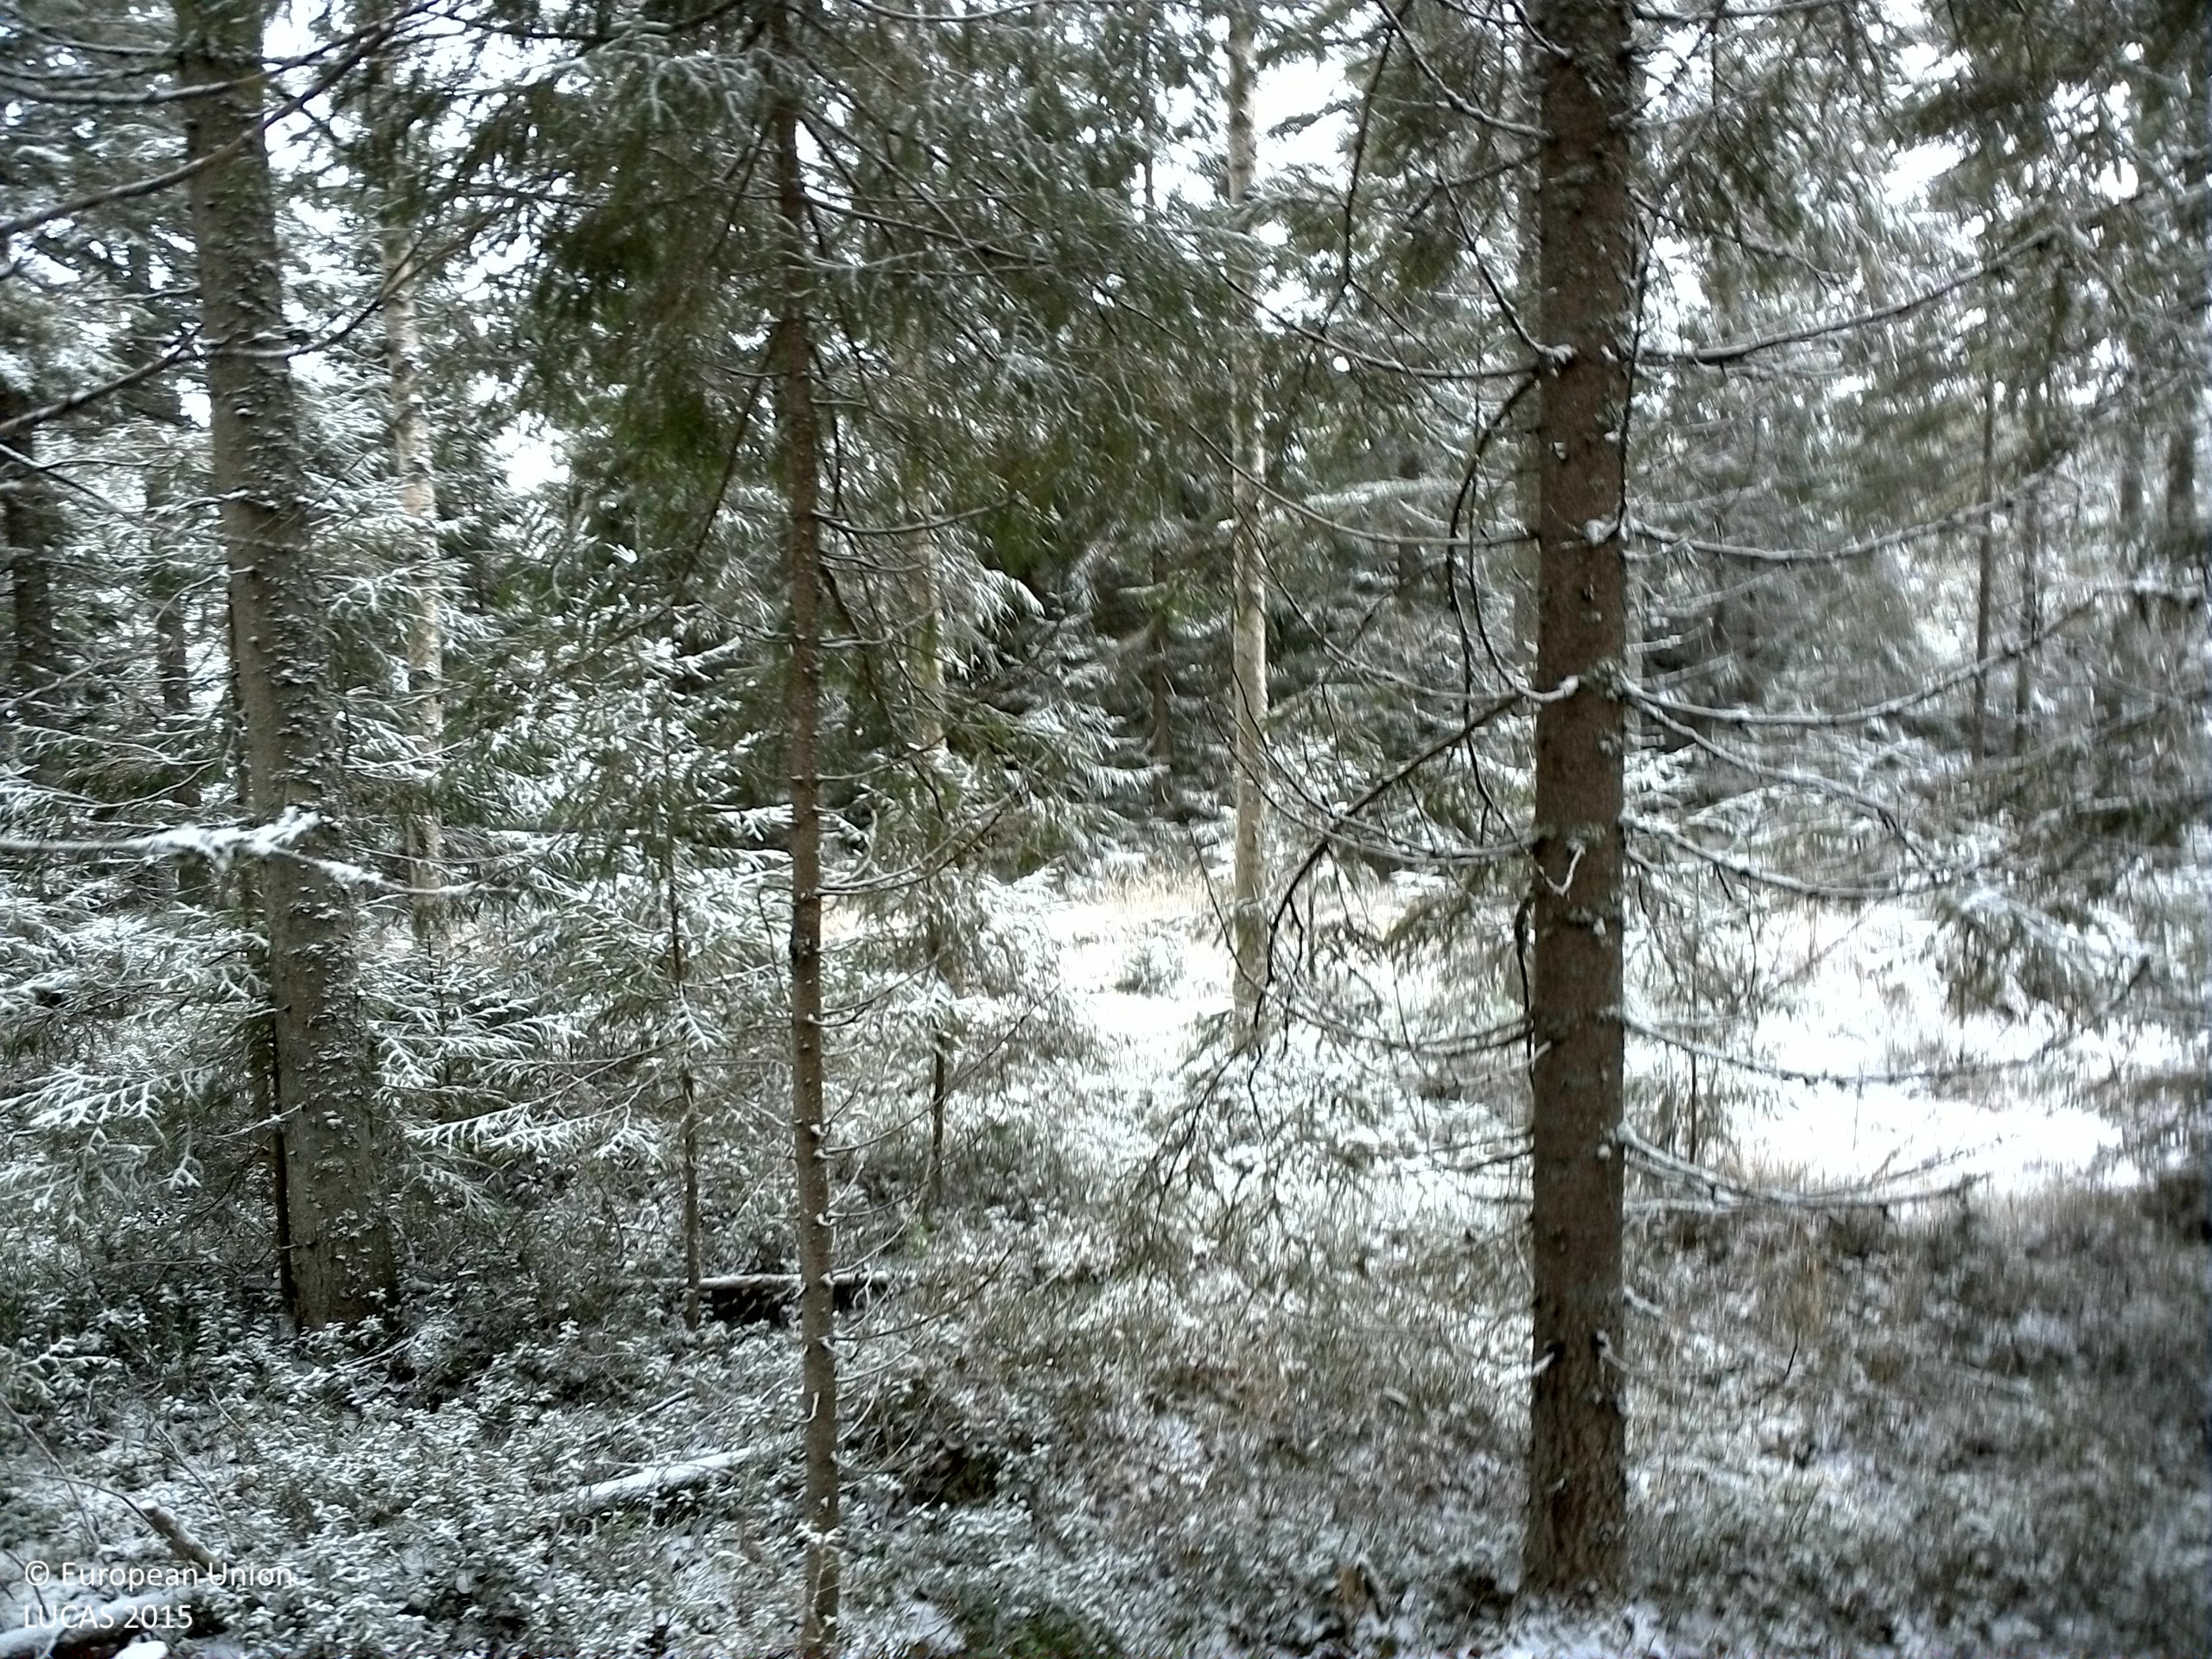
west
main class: Woodland
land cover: Spruce dominated mixed woodland
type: boreal forest
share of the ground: 50 - 75 %
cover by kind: coniferous forest trees 50 %, shrubs 25 %, broadleaved forest trees 20 %, herbaceous plants 5 %
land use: Forestry
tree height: > 5 m
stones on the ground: < 10 %
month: November
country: SE
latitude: 59.9642
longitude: 15.5240
